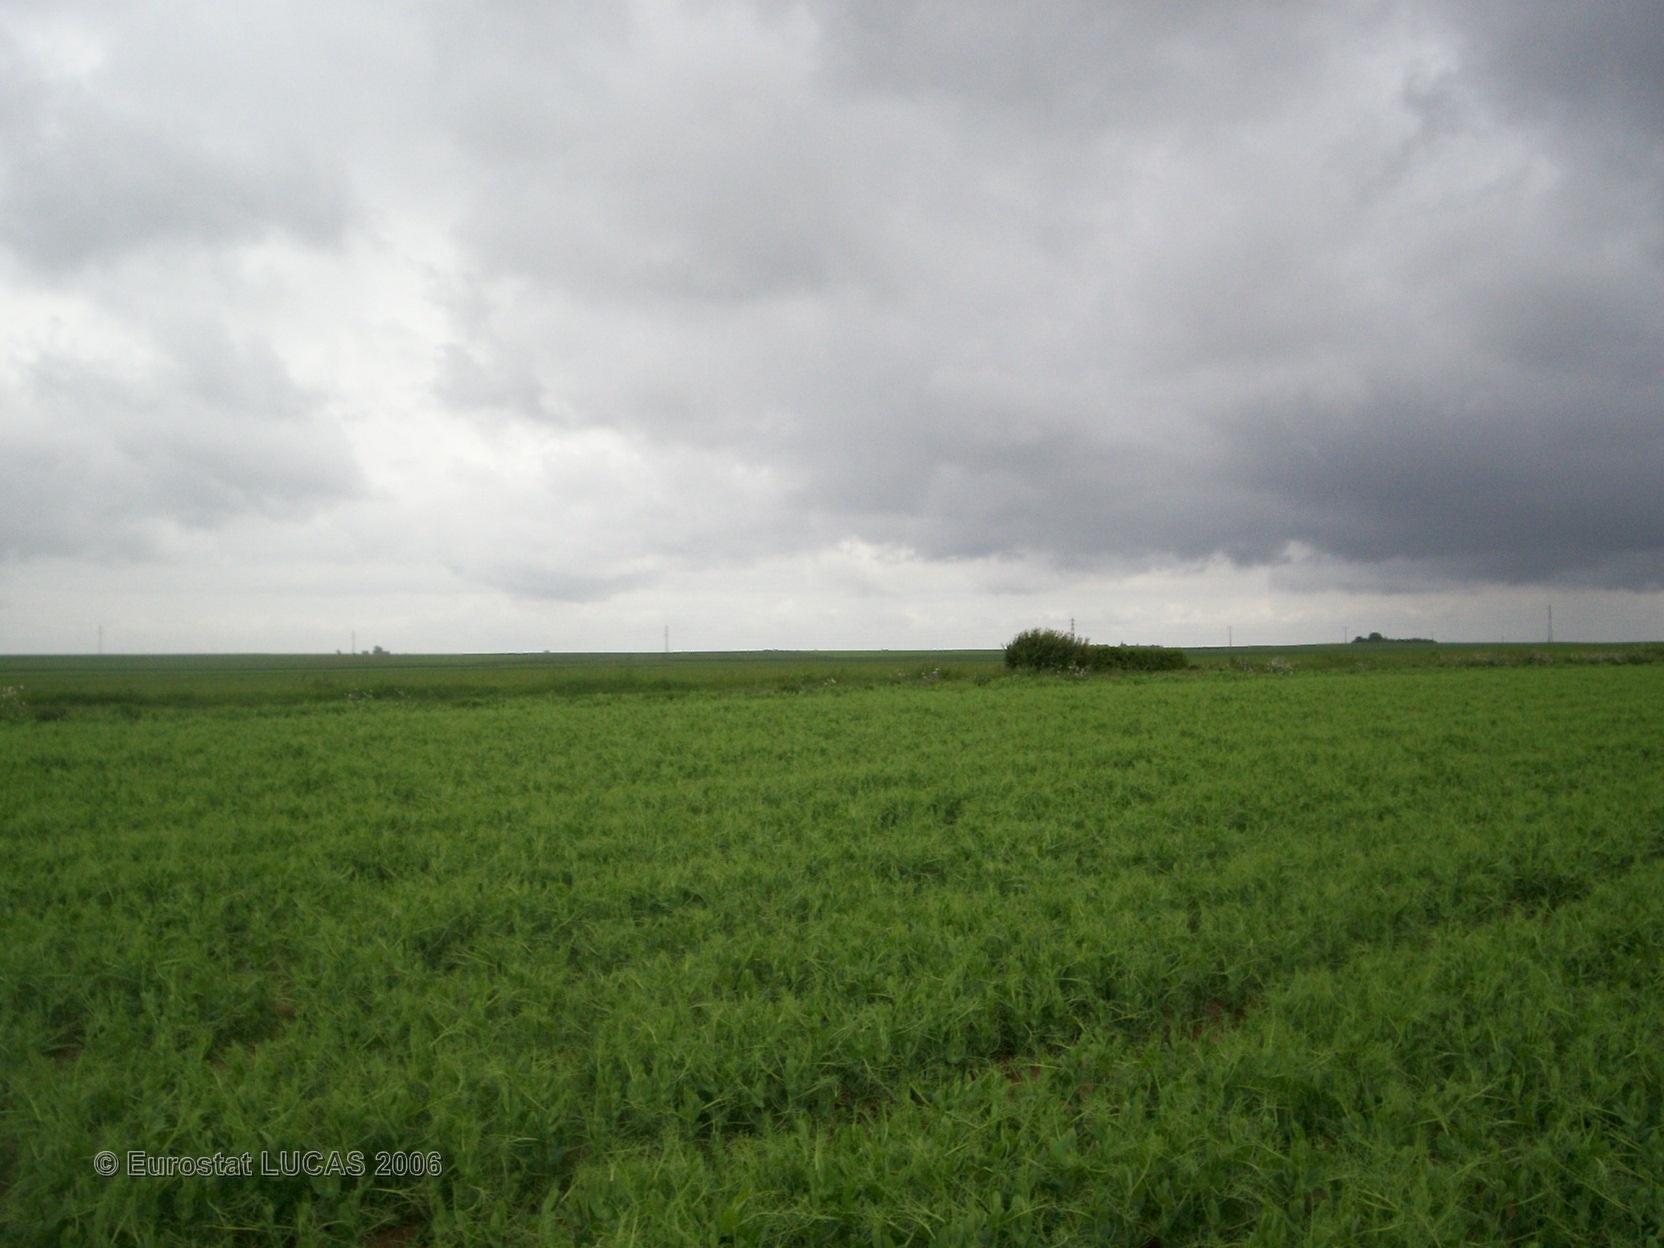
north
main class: Cropland
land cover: Dry pulses
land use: Agriculture (excluding fallow land and kitchen gardens)
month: May
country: FR
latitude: 49.2670
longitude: 2.7472
